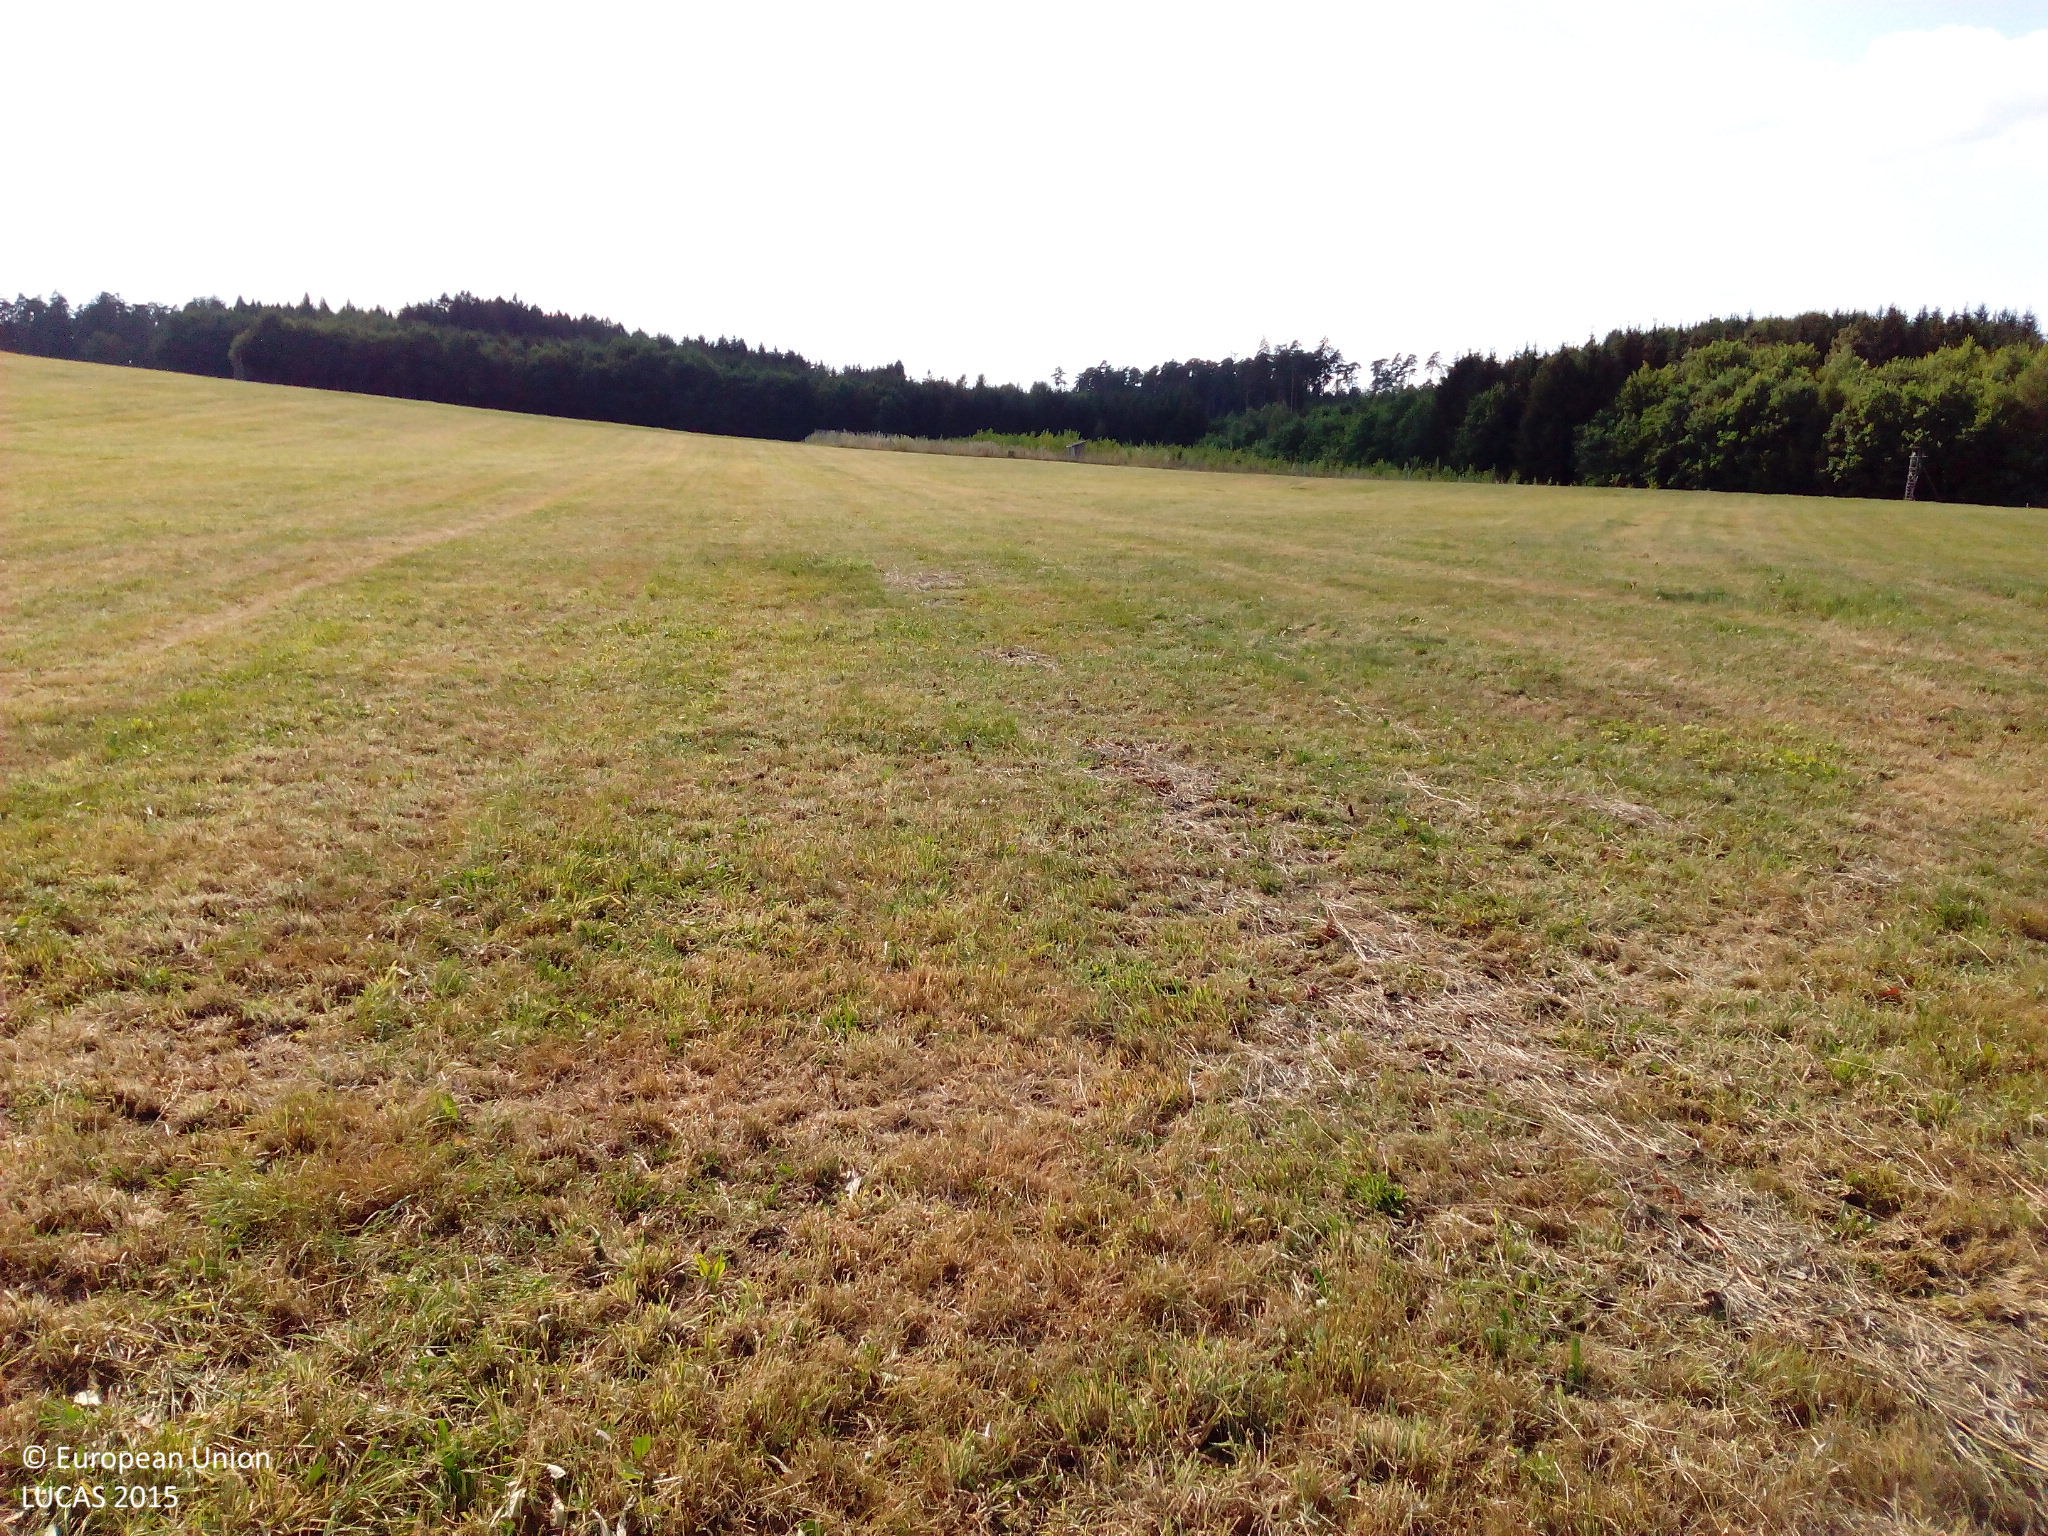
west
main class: Grassland
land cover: Grassland without tree/shrub cover
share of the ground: > 75 %
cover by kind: herbaceous plants 100 %
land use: Agriculture (excluding fallow land and kitchen gardens)
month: August
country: DE
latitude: 49.0329
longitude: 10.2598
